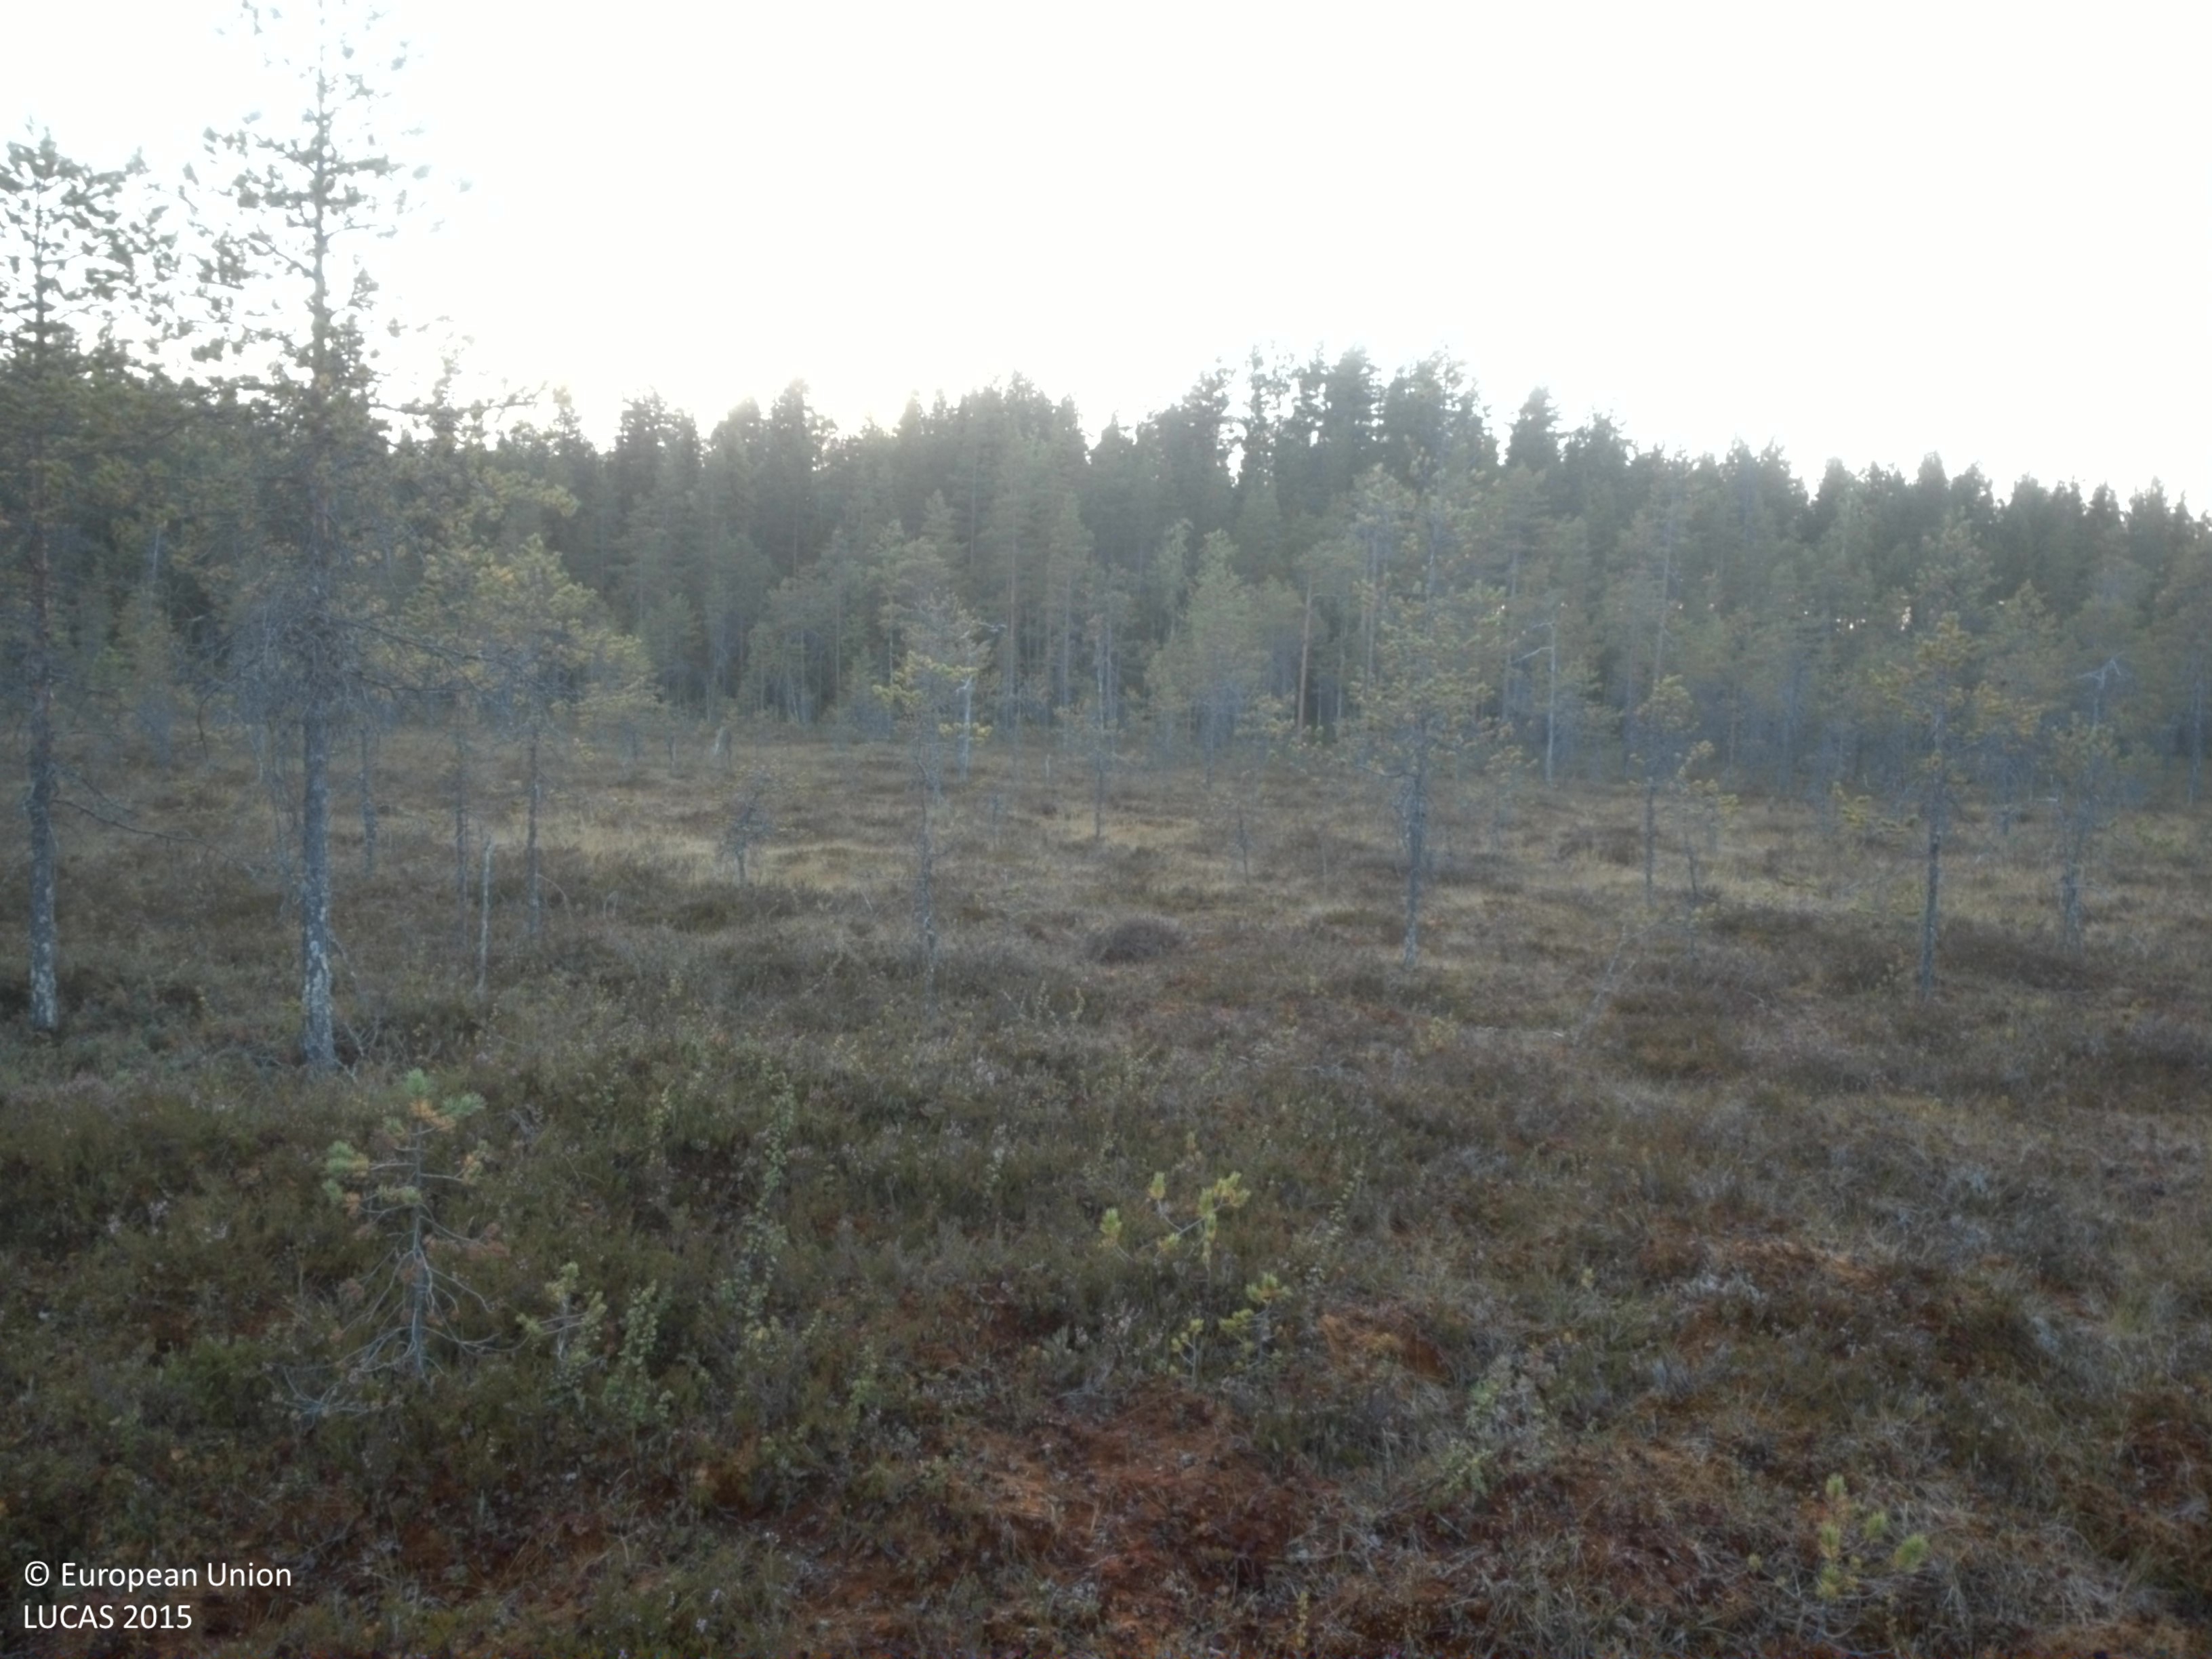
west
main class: Shrubland
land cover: Shrubland with sparse tree cover
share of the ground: > 75 %
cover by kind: shrubs 75 %, herbaceous plants 10 %, lichens and mosses 10 %, coniferous forest trees 5 %
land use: Semi-natural and natural areas not in use
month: August
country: SE
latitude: 64.4891
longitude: 18.9806
